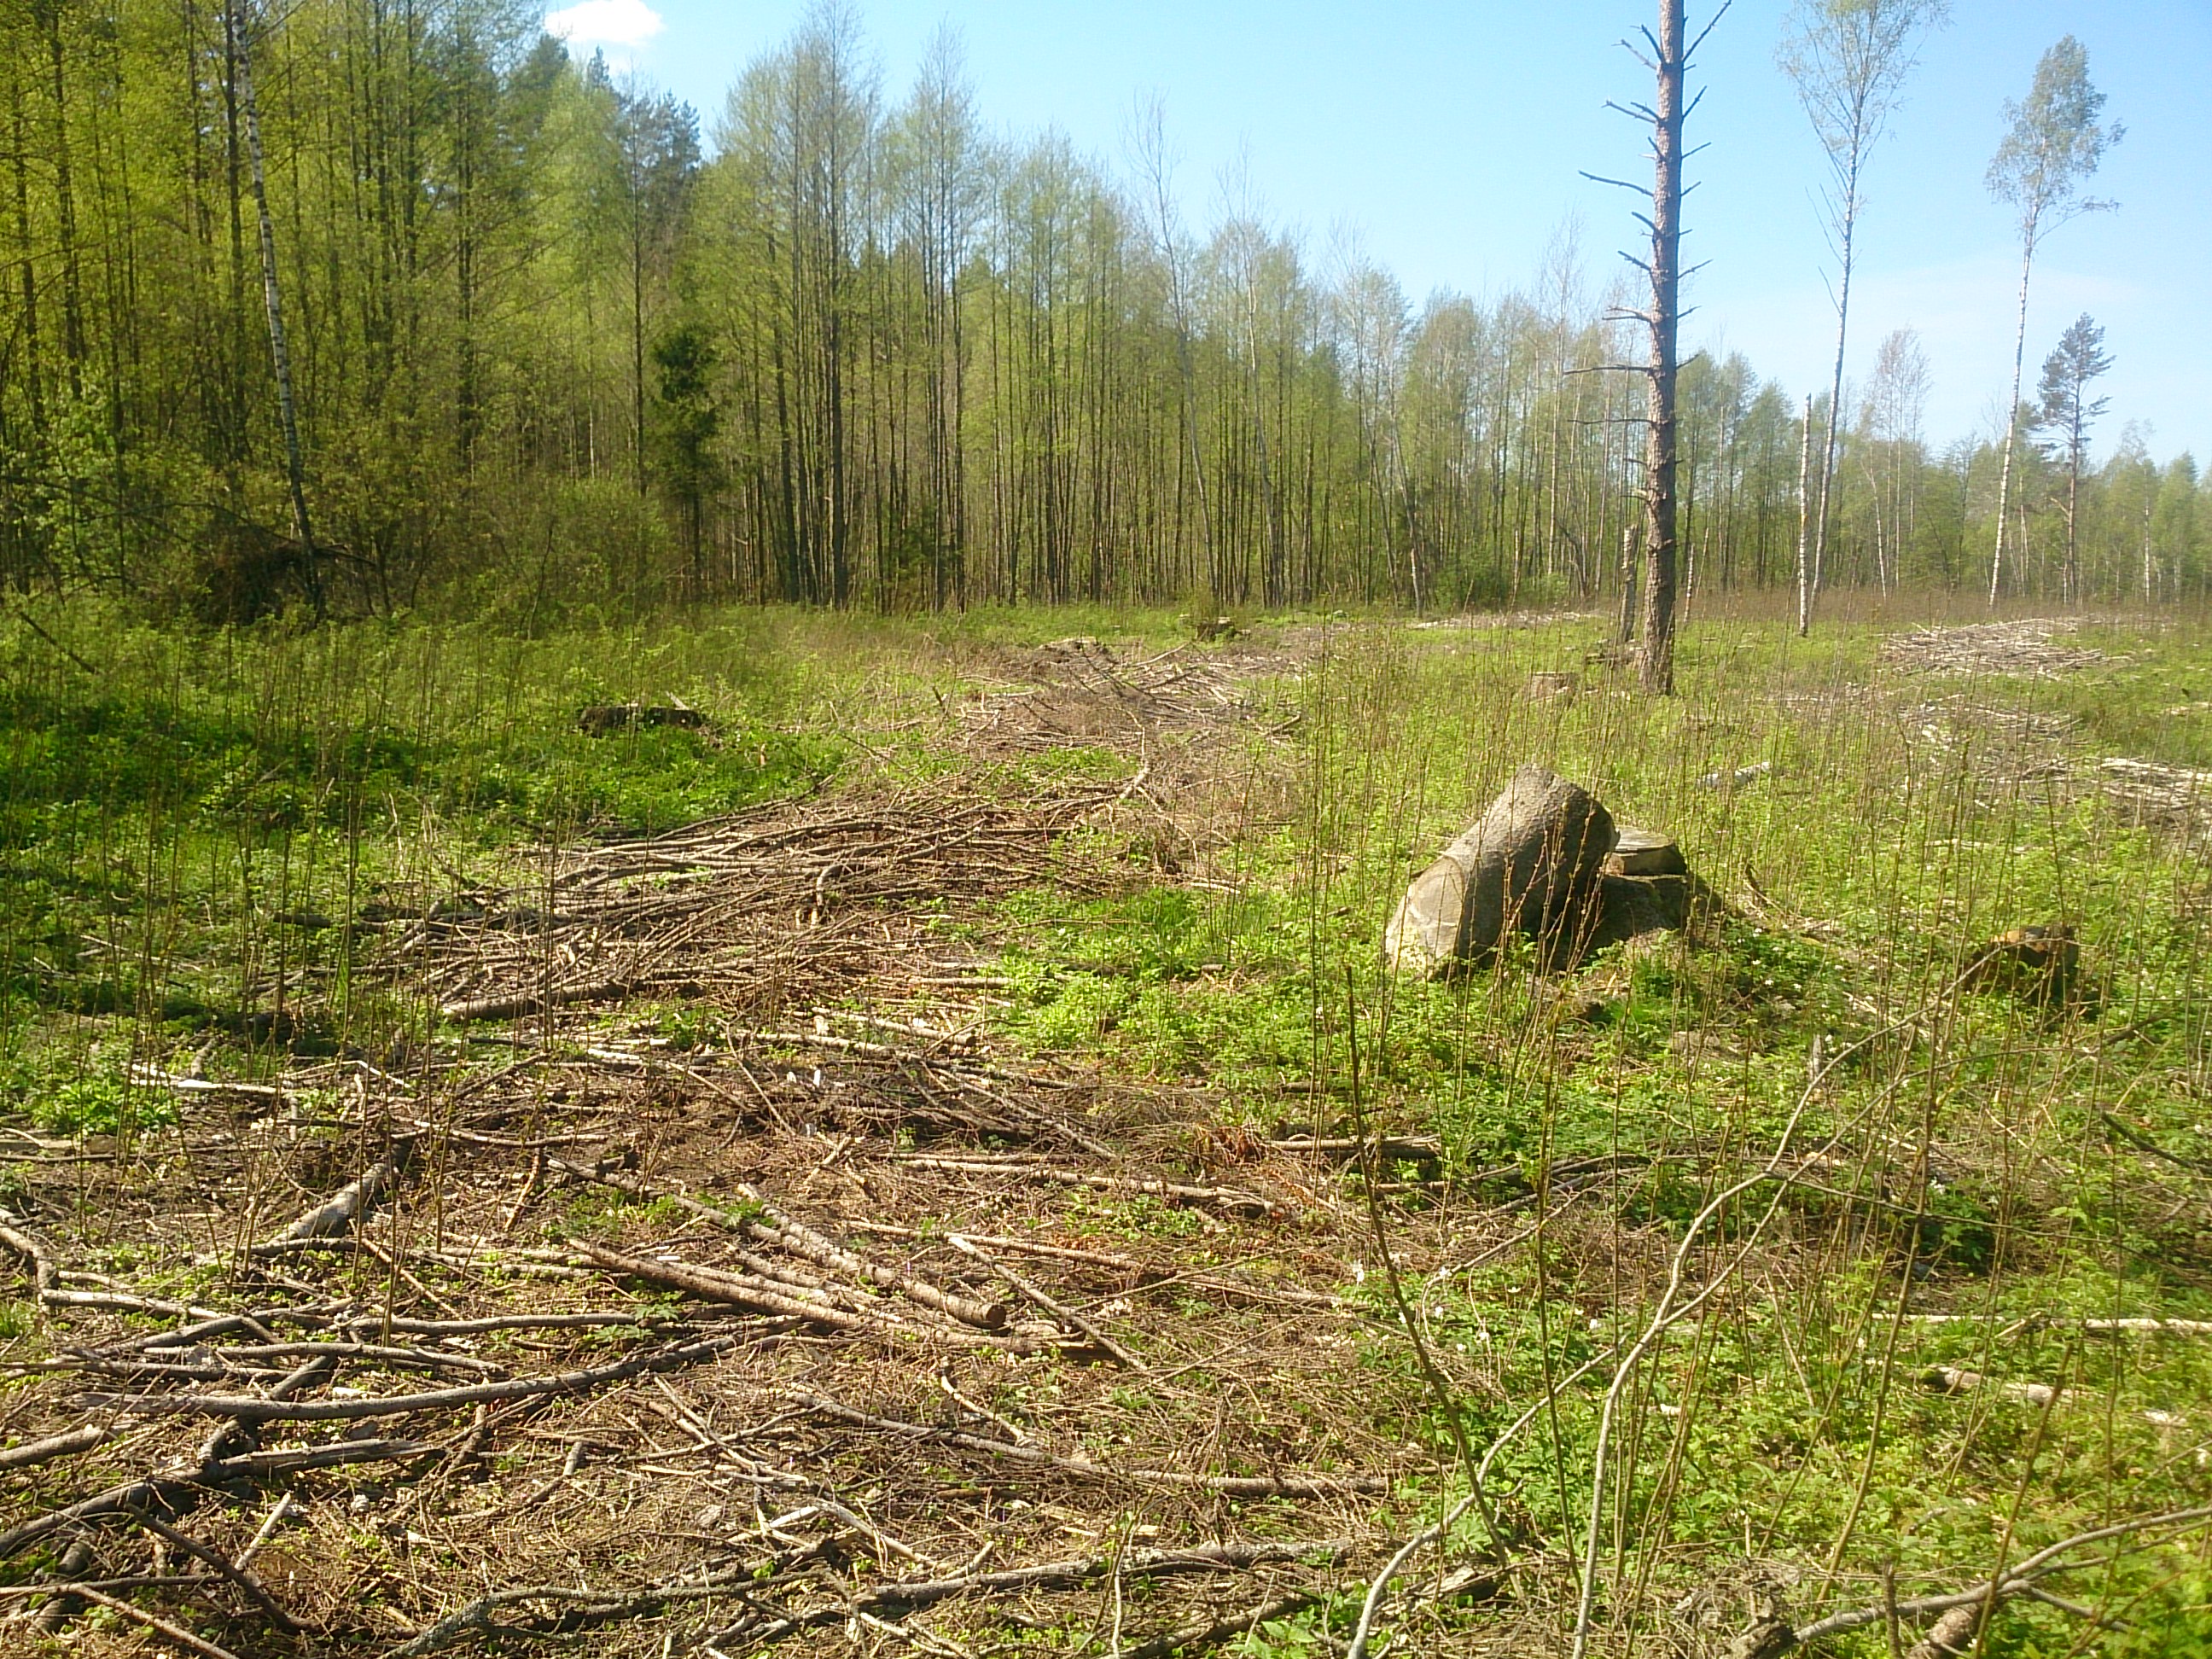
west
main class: Shrubland
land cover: Shrubland with sparse tree cover
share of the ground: 50 - 75 %
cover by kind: shrubs 55 %, herbaceous plants 30 %, unconsolidated bare surface 10 %, coniferous forest trees 5 %
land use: Forestry
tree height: > 5 m
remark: Clear cut
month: May
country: LV
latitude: 56.6861
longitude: 24.4105
